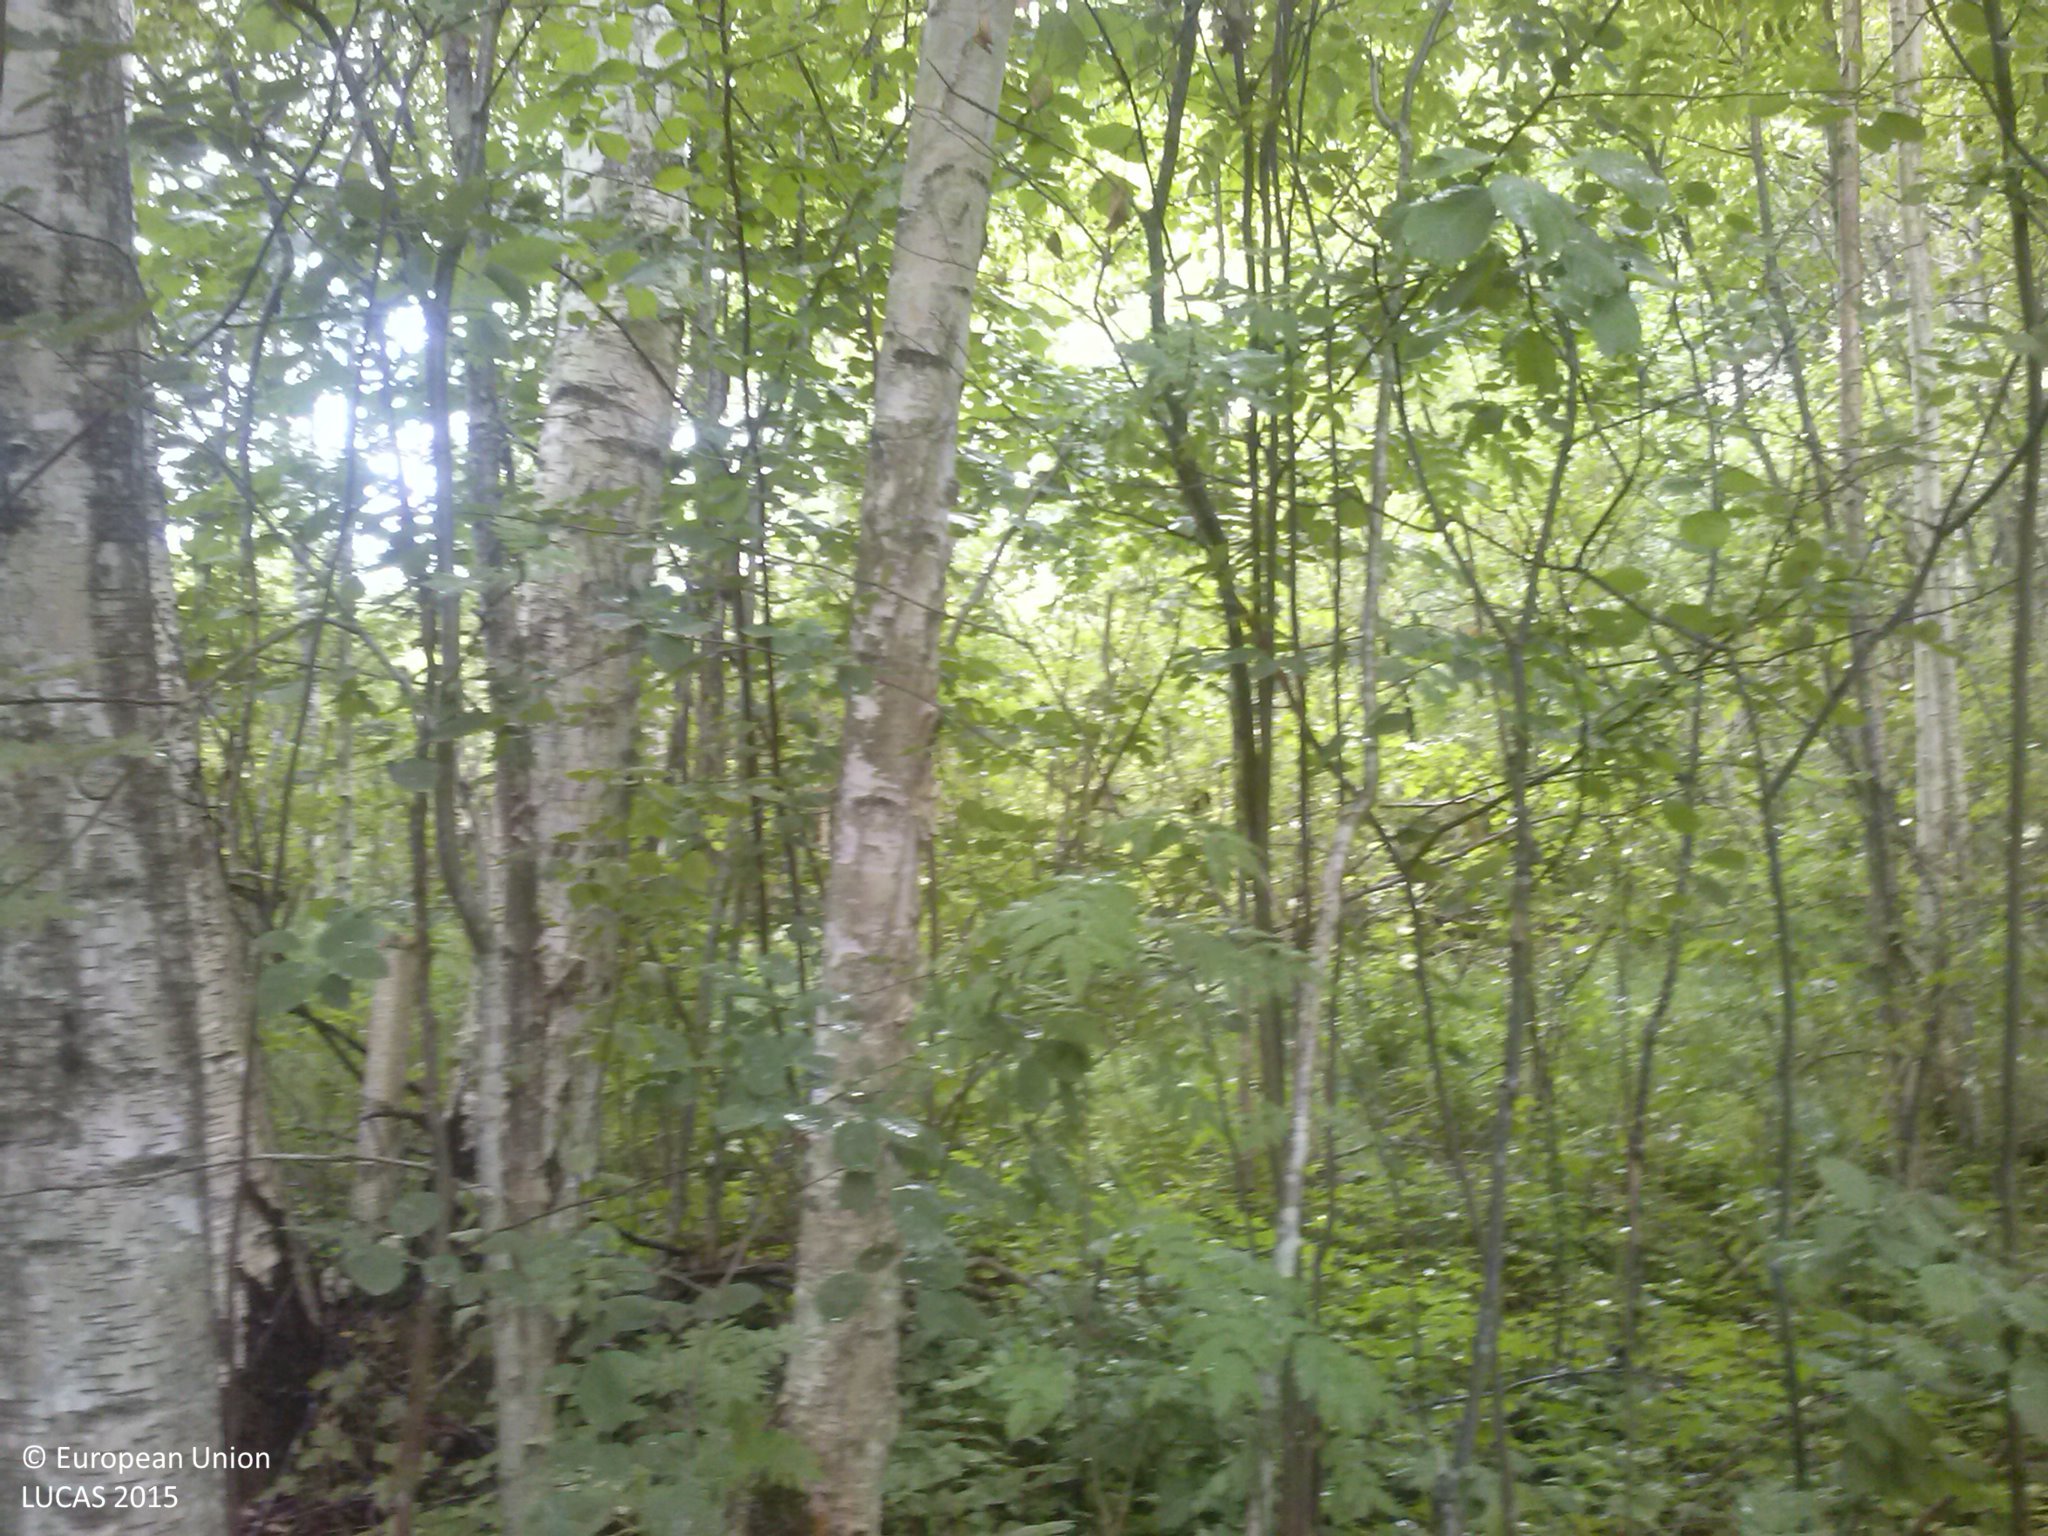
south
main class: Woodland
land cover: Broadleaved woodland
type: non-riverine alder, birch or aspen forest
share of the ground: > 75 %
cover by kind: broadleaved forest trees 75 %, herbaceous plants 25 %
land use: Forestry
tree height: > 5 m
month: July
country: LV
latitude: 56.6959
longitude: 27.5718
